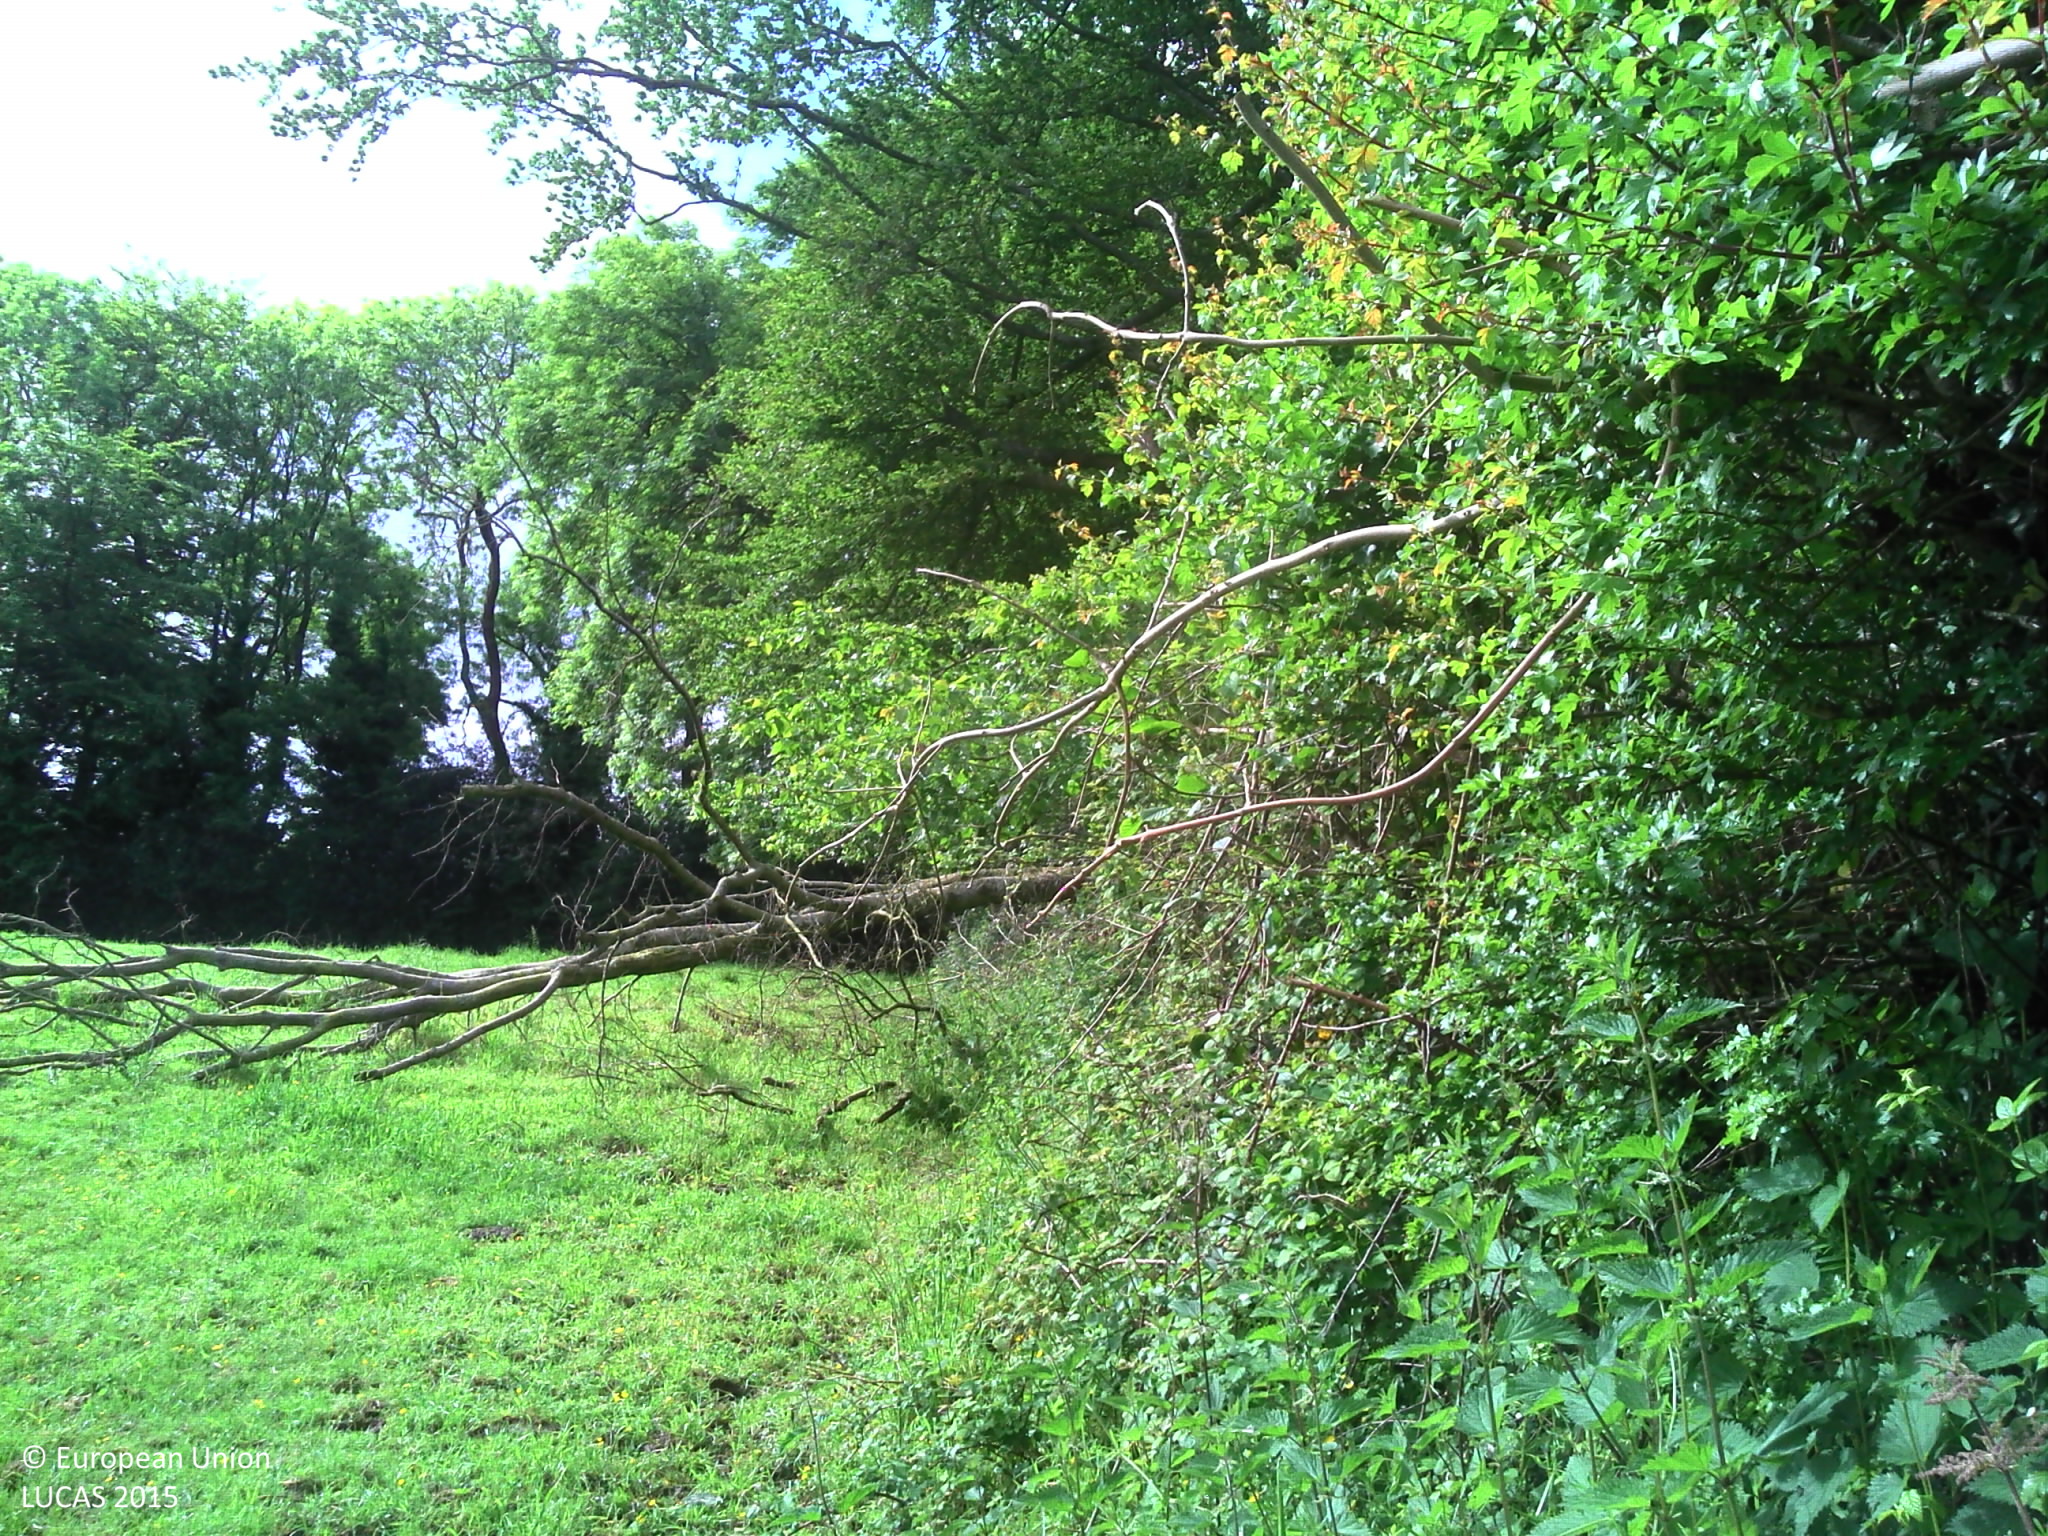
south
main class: Grassland
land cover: Grassland without tree/shrub cover
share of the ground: > 75 %
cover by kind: herbaceous plants 100 %
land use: Agriculture (excluding fallow land and kitchen gardens)
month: June
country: FR
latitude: 49.5519
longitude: -1.7890
